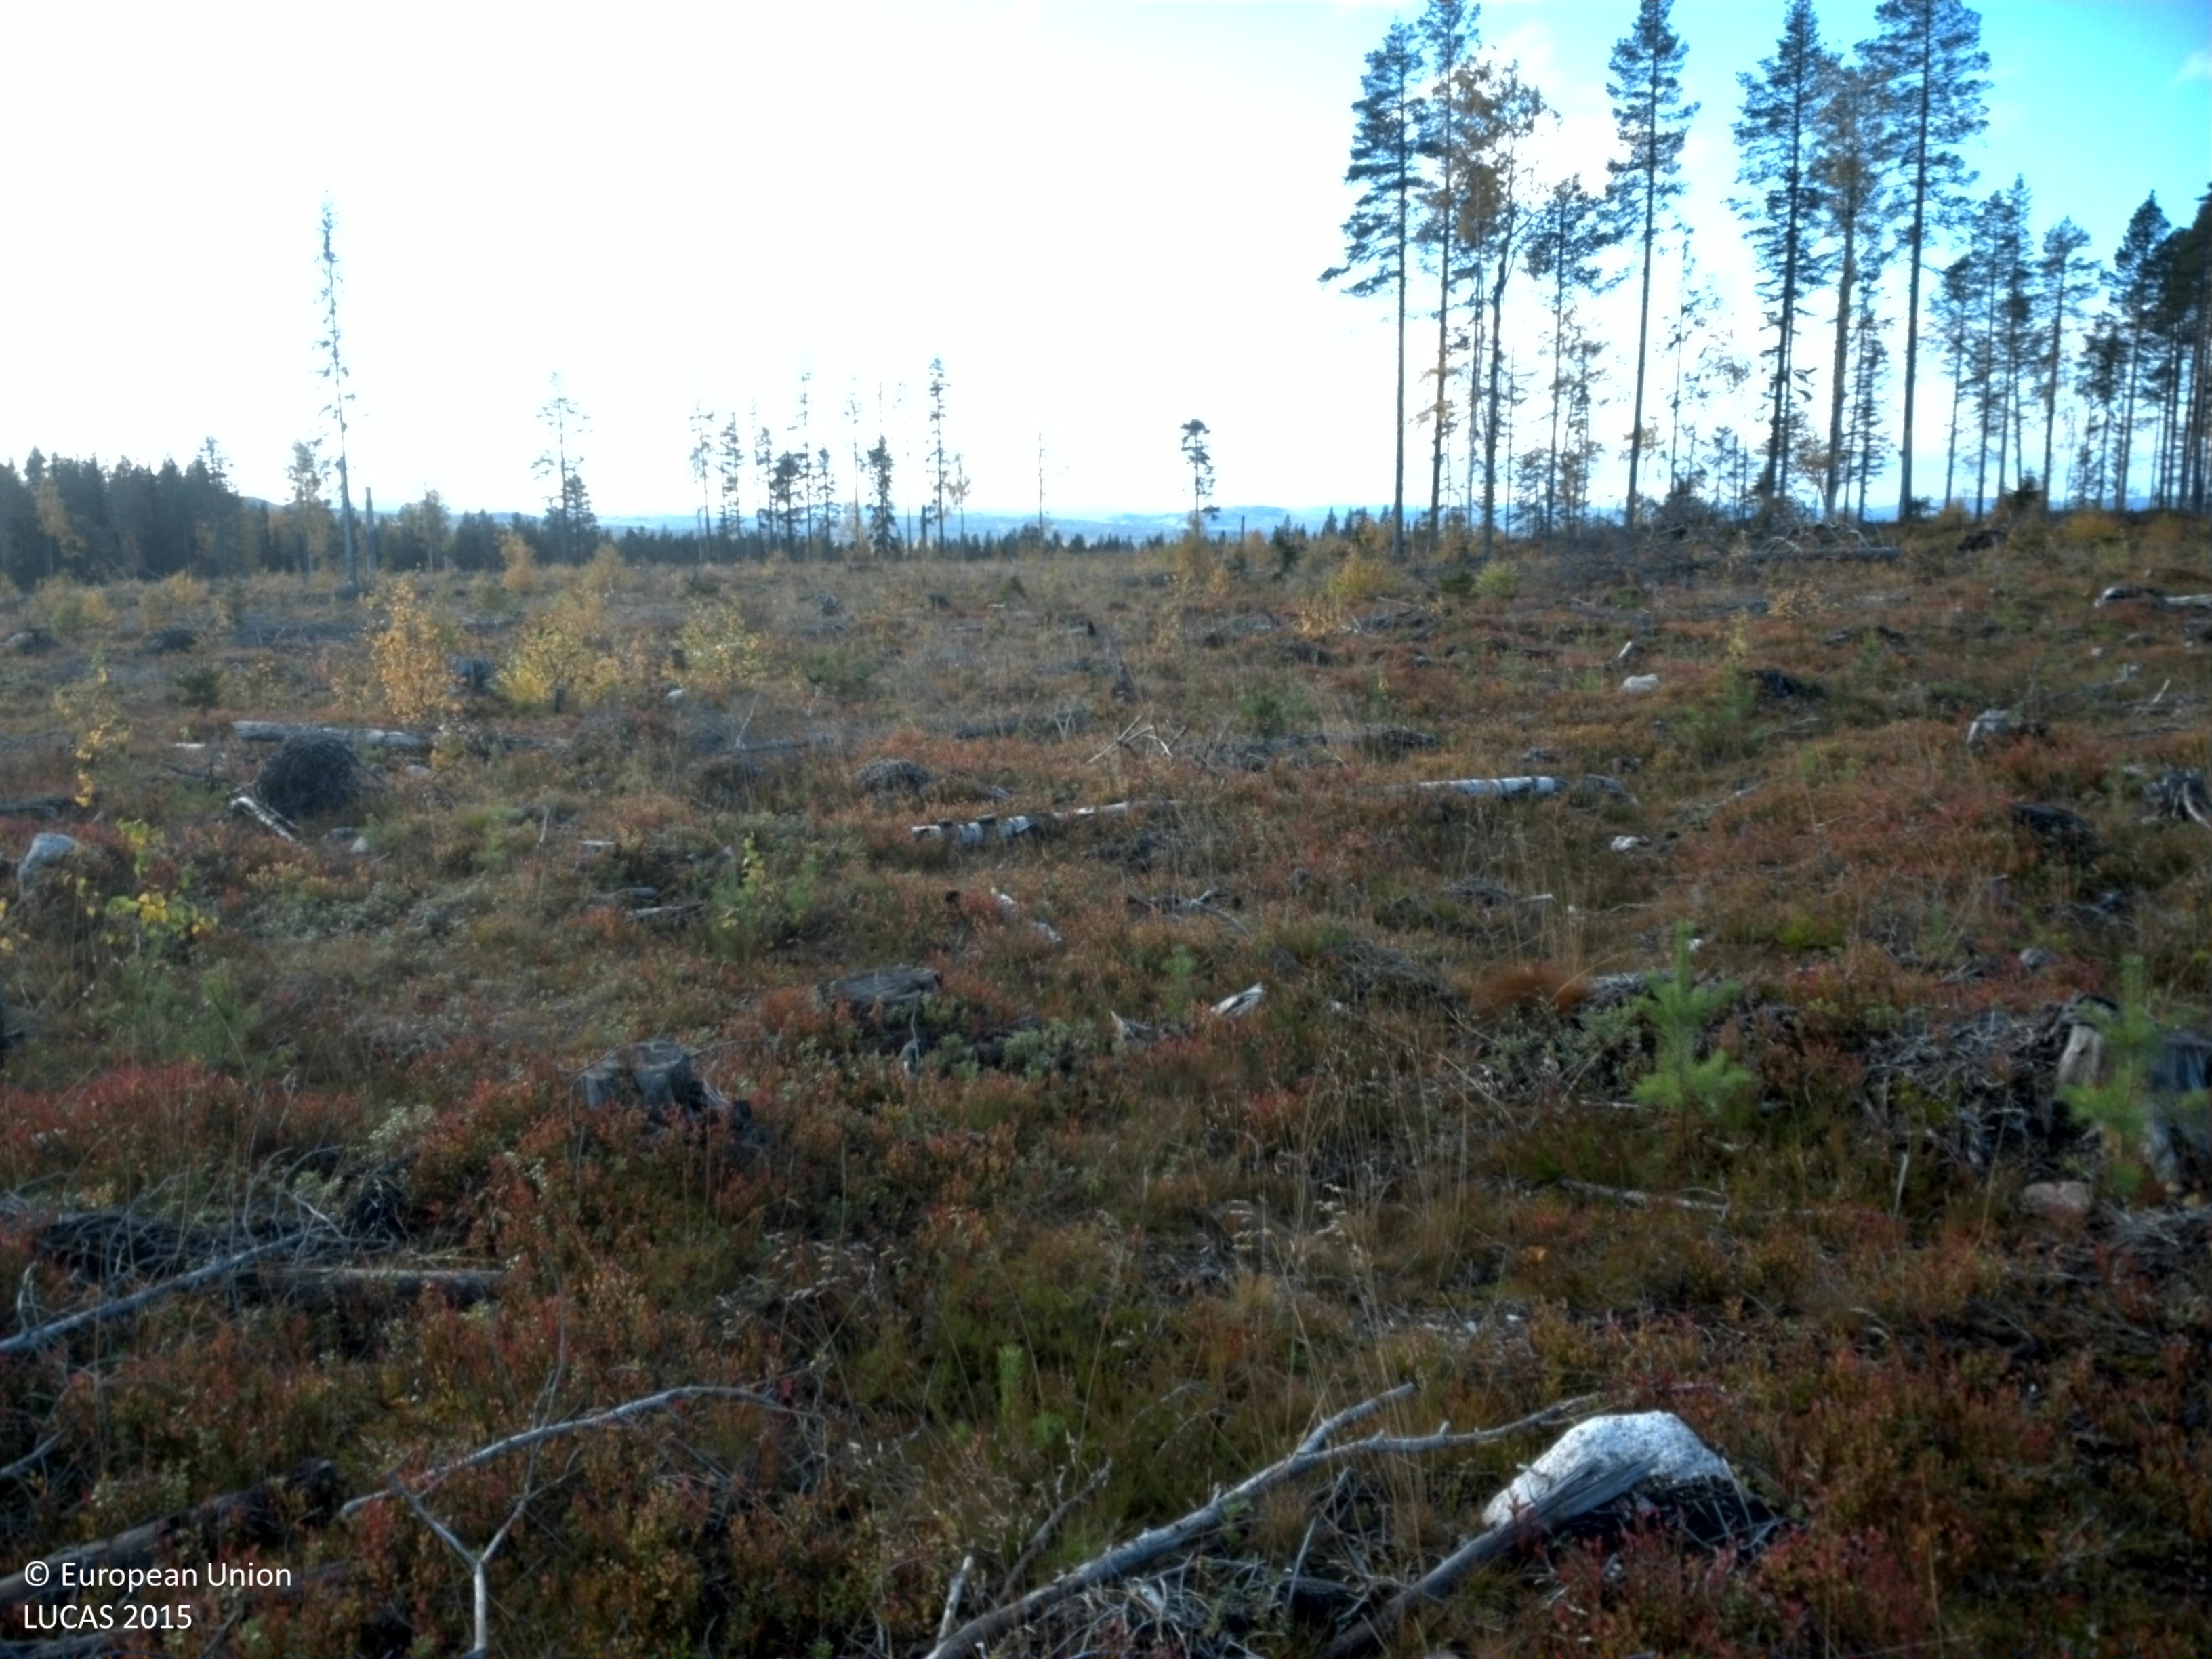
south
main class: Shrubland
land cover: Shrubland without tree cover
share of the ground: 50 - 75 %
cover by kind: shrubs 60 %, herbaceous plants 20 %, unconsolidated bare surface 10 %, lichens and mosses 5 %
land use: Forestry
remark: Clear cut
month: September
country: SE
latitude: 65.0198
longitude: 17.8794
